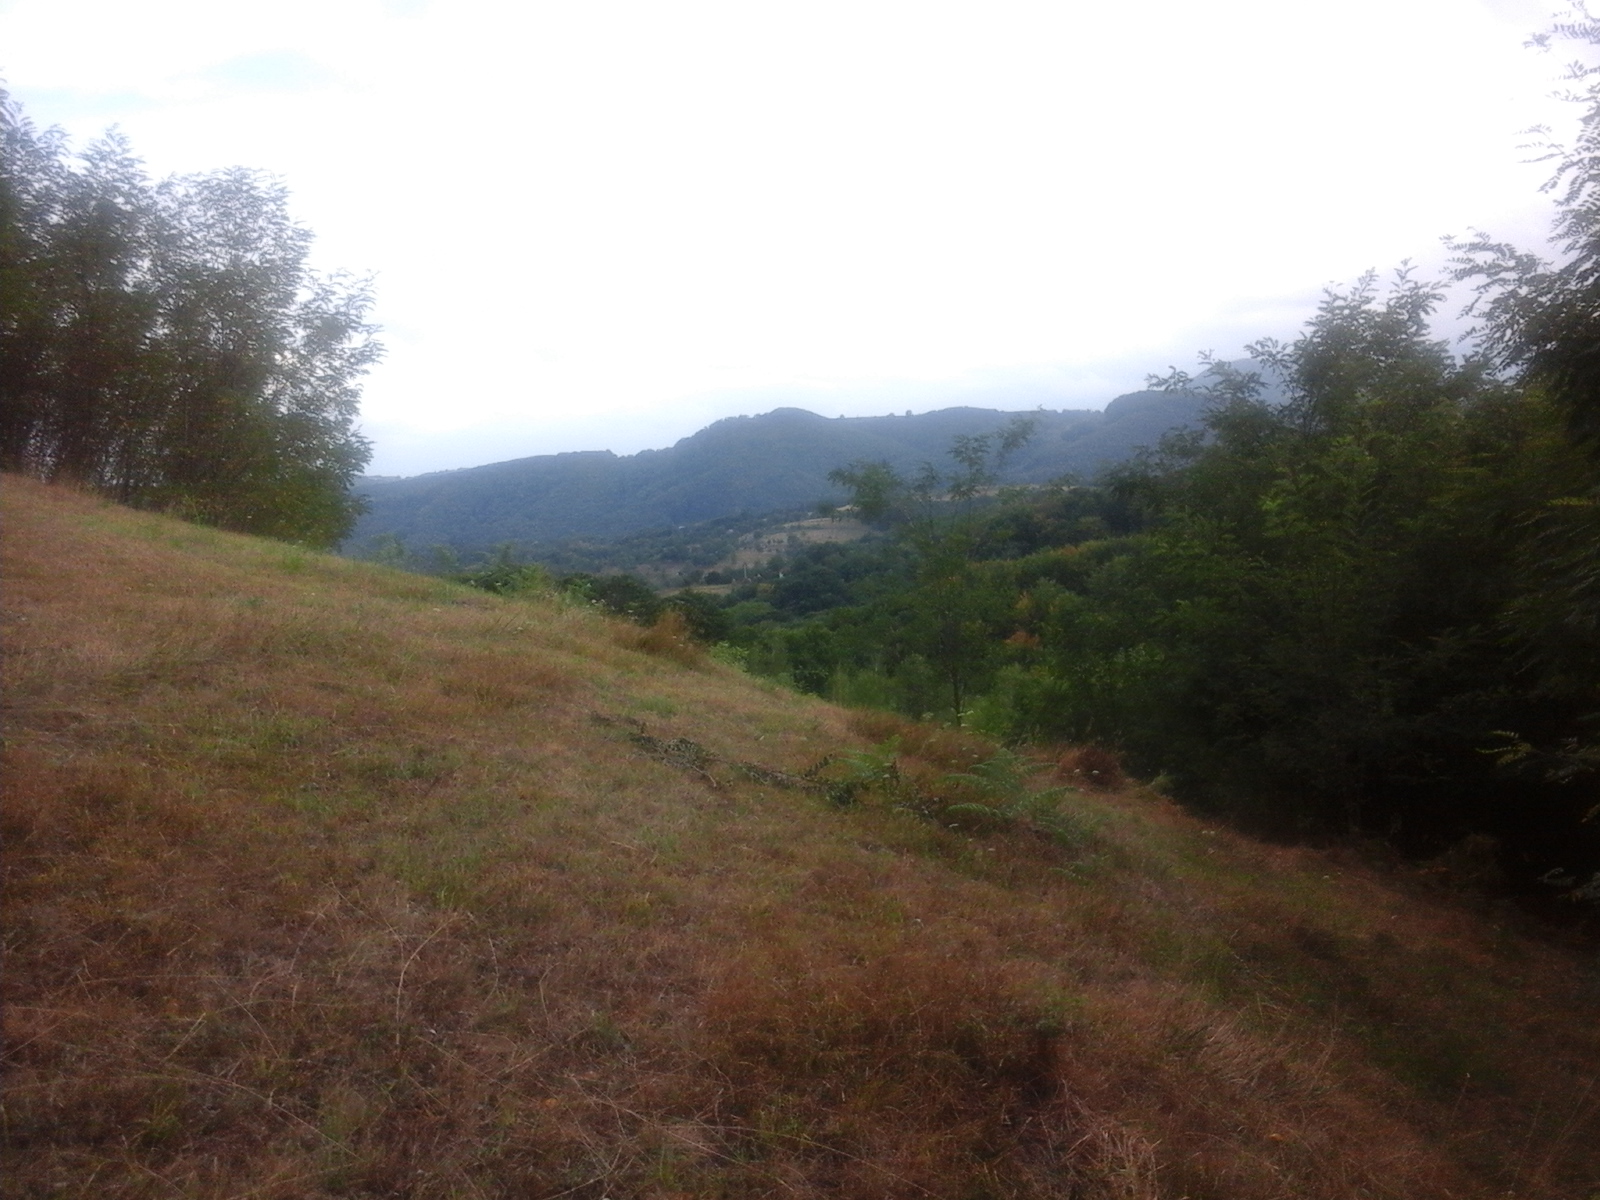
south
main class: Woodland
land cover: Broadleaved woodland
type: exotic forest
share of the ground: > 75 %
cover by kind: broadleaved forest trees 100 %
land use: Forestry
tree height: > 5 m
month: August
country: RO
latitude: 44.9873
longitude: 22.7153
